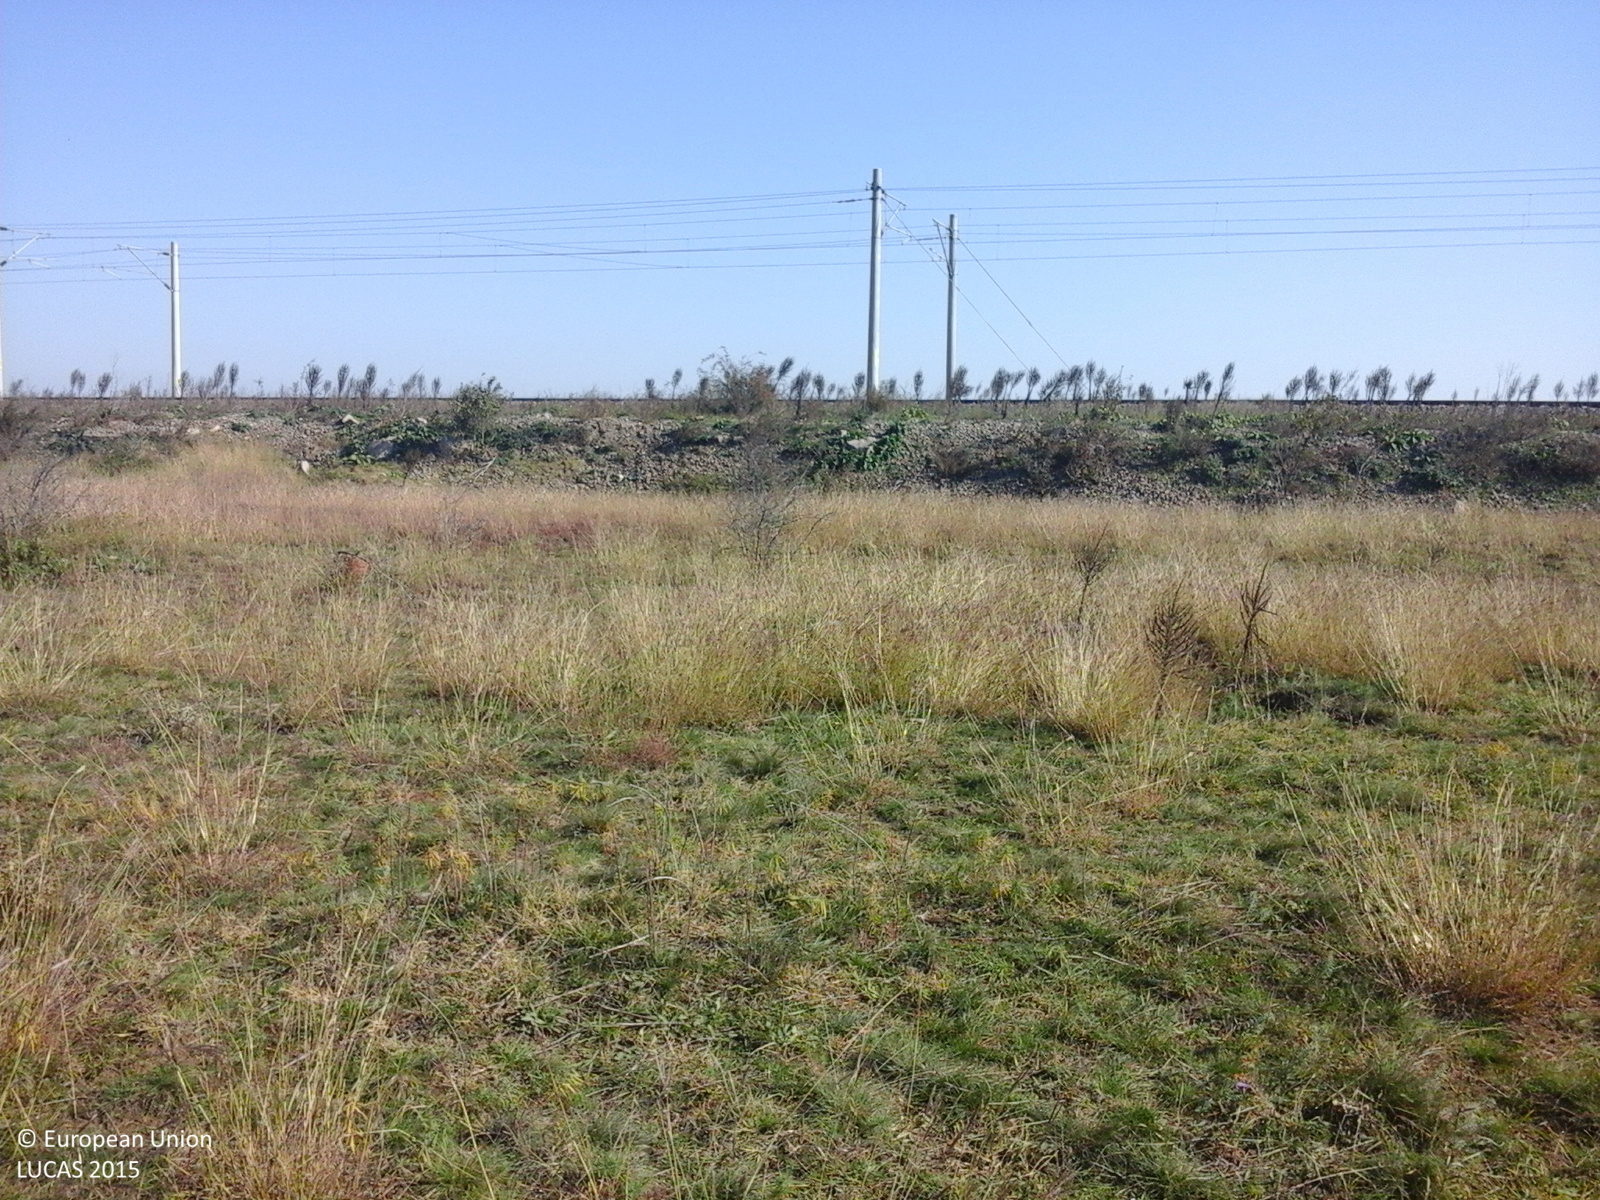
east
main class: Grassland
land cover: Grassland without tree/shrub cover
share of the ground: > 75 %
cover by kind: herbaceous plants 100 %
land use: Agriculture (excluding fallow land and kitchen gardens)
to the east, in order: Grassland without tree/shrub cover; Spontaneously vegetated surfaces; Electric lines; Railways; Electric lines; Grassland without tree/shrub cover; Tracks; Grassland with sparse tree/shrub cover
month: October
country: RO
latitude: 45.7920
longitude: 27.1925
